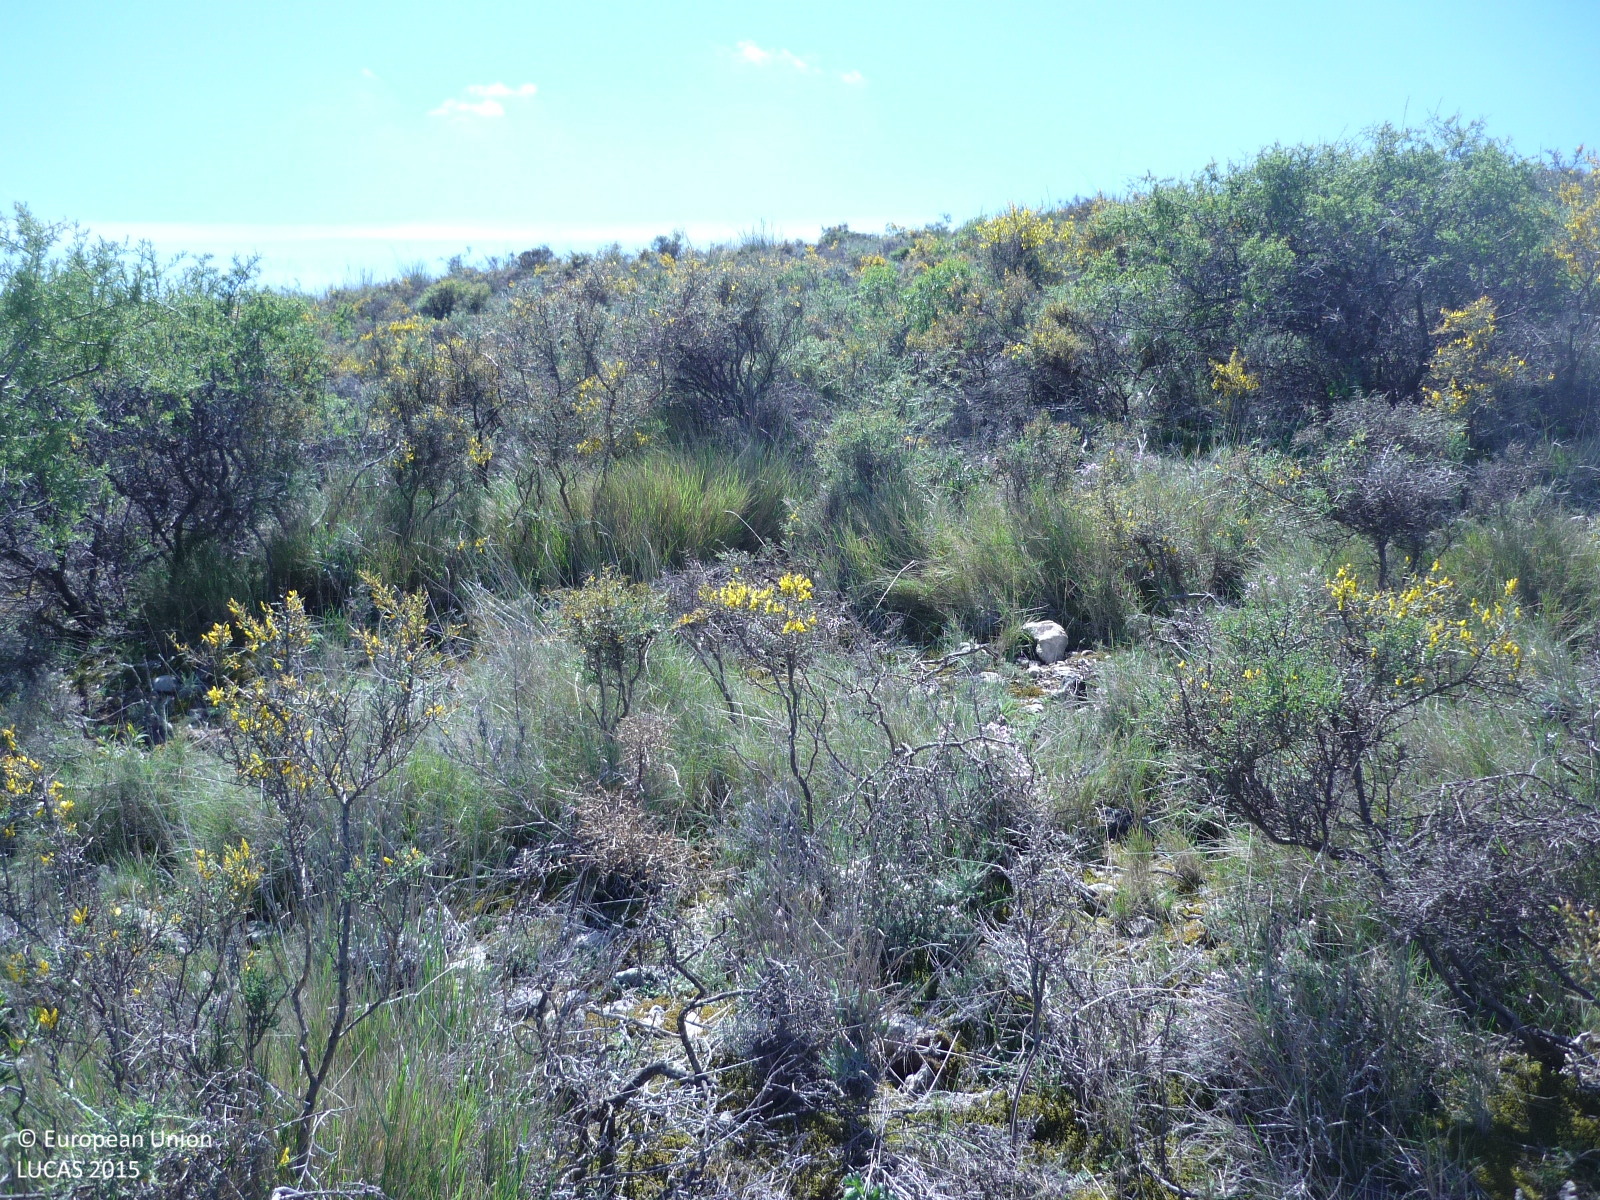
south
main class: Shrubland
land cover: Shrubland without tree cover
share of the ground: > 75 %
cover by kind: shrubs 75 %, herbaceous plants 25 %
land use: Semi-natural and natural areas not in use
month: April
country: ES
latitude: 40.7681
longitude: -3.5575
